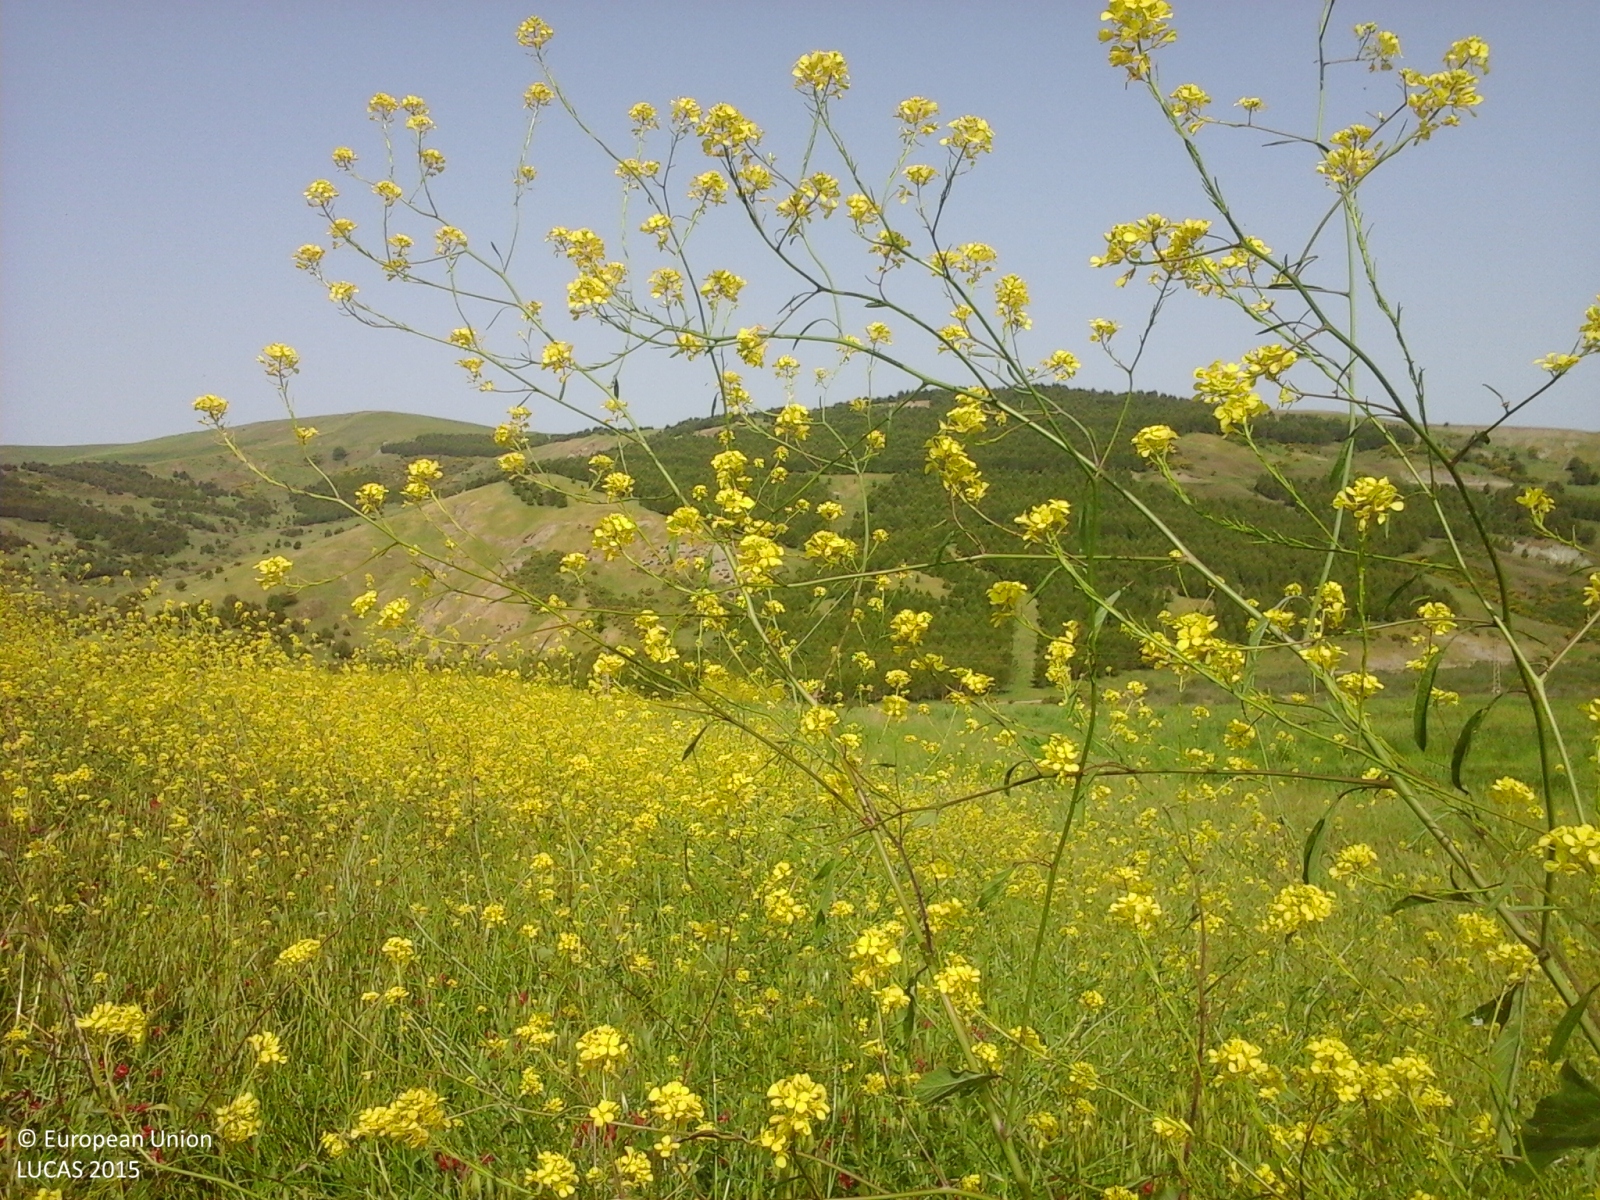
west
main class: Cropland
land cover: Temporary grasslands
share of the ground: > 75 %
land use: Agriculture (excluding fallow land and kitchen gardens)
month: May
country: IT
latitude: 37.7303
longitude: 14.1344
